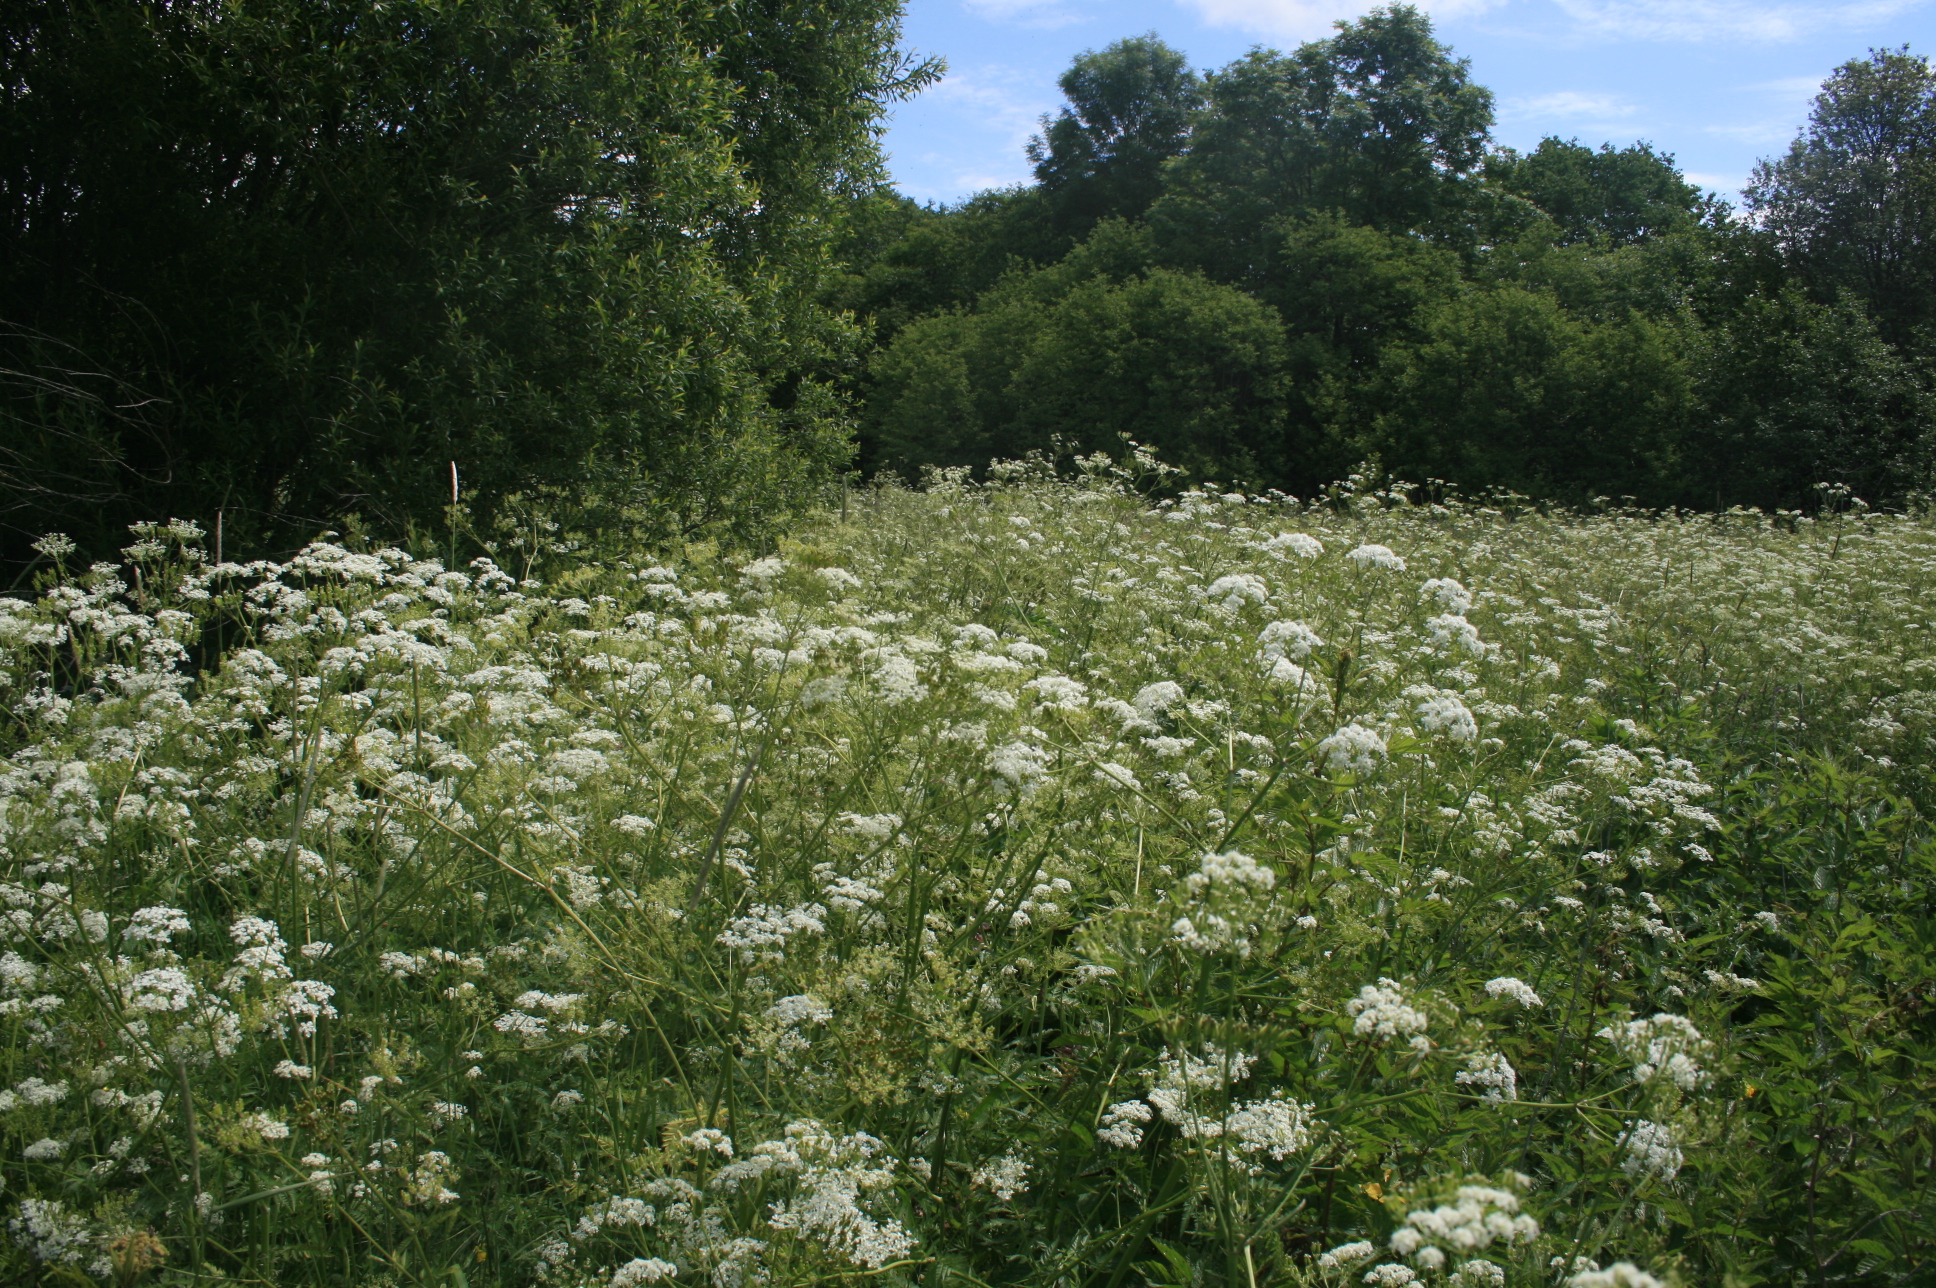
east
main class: Grassland
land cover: Spontaneously vegetated surfaces
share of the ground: > 75 %
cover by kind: herbaceous plants 100 %
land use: Fallow land
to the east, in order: Spontaneously vegetated surfaces; Broadleaved woodland; Inland fresh running water; Broadleaved woodland; Grassland without tree/shrub cover; Broadleaved woodland; Artificial constructions in urban areas
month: June
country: LT
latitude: 55.2643
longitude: 22.1258
